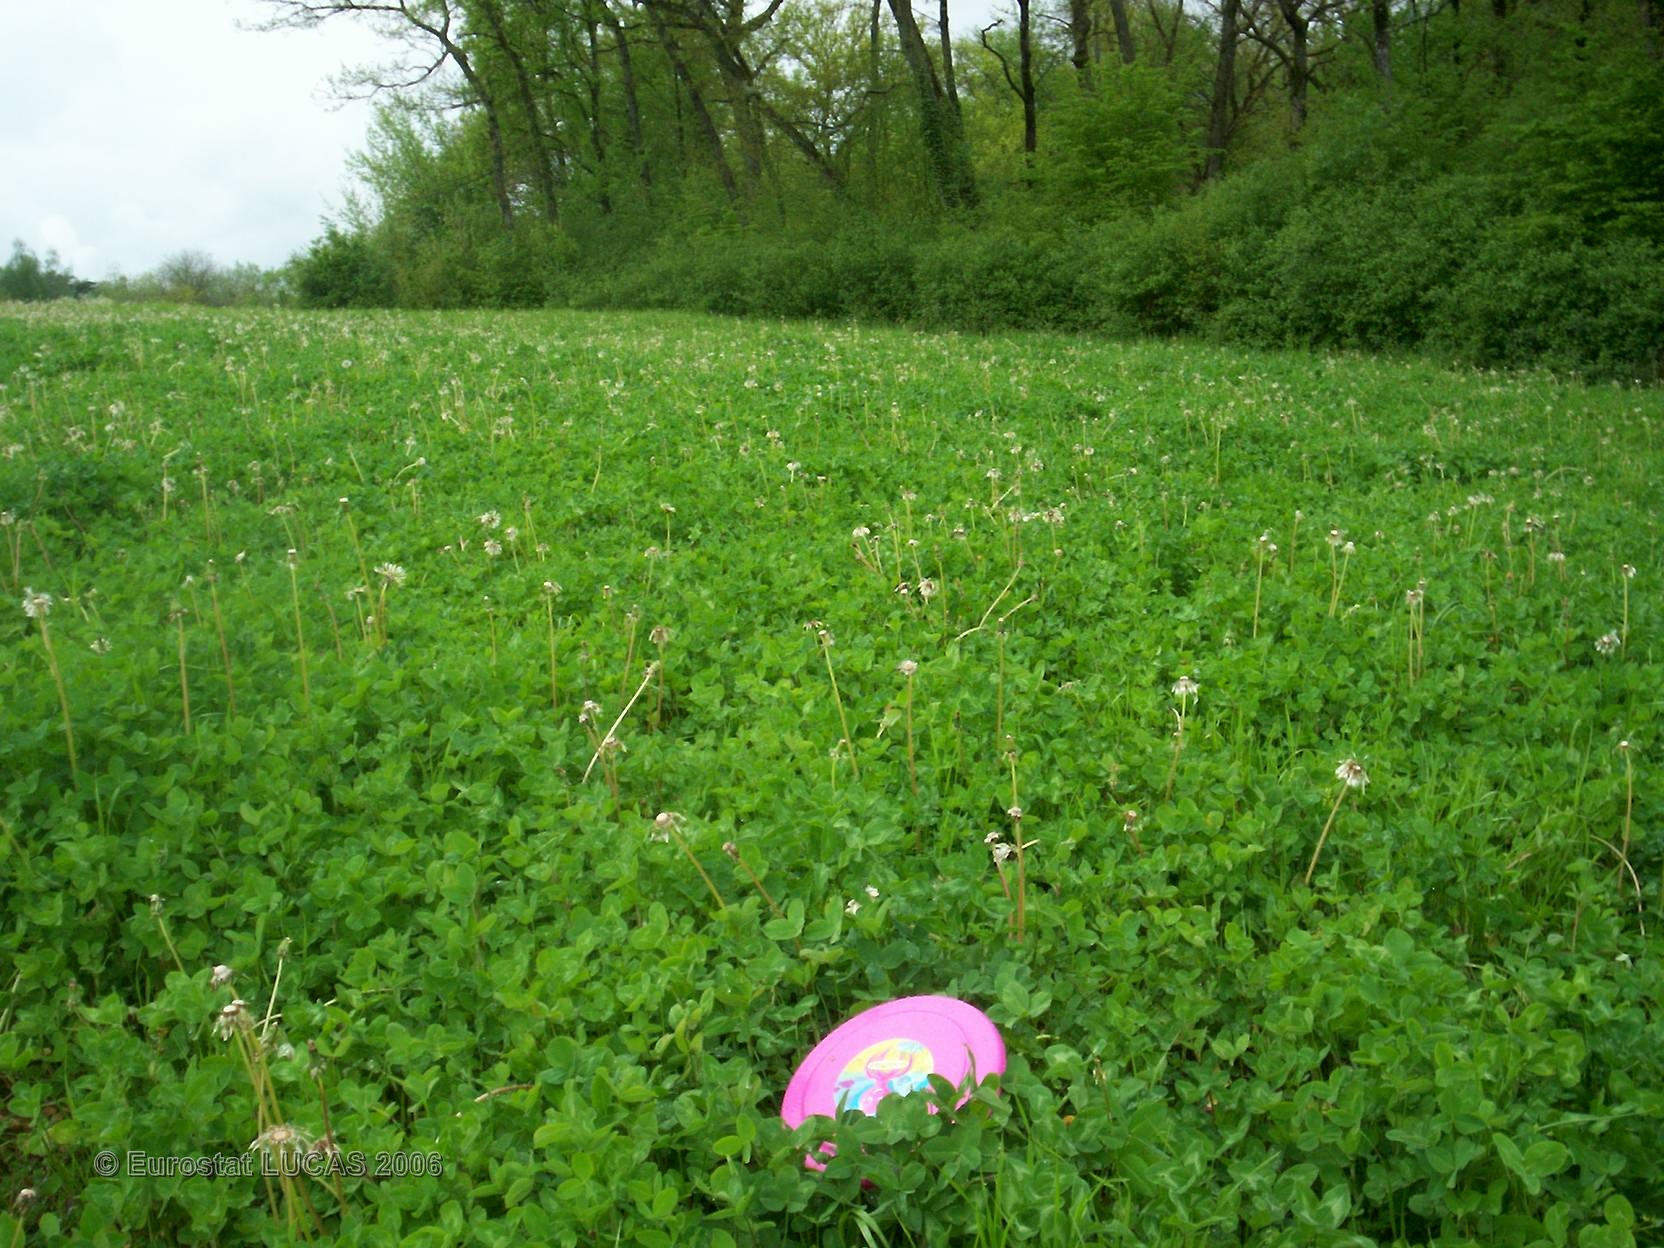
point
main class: Cropland
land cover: Clovers
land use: Agriculture (excluding fallow land and kitchen gardens)
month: May
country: FR
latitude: 47.7304
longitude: 4.5988
